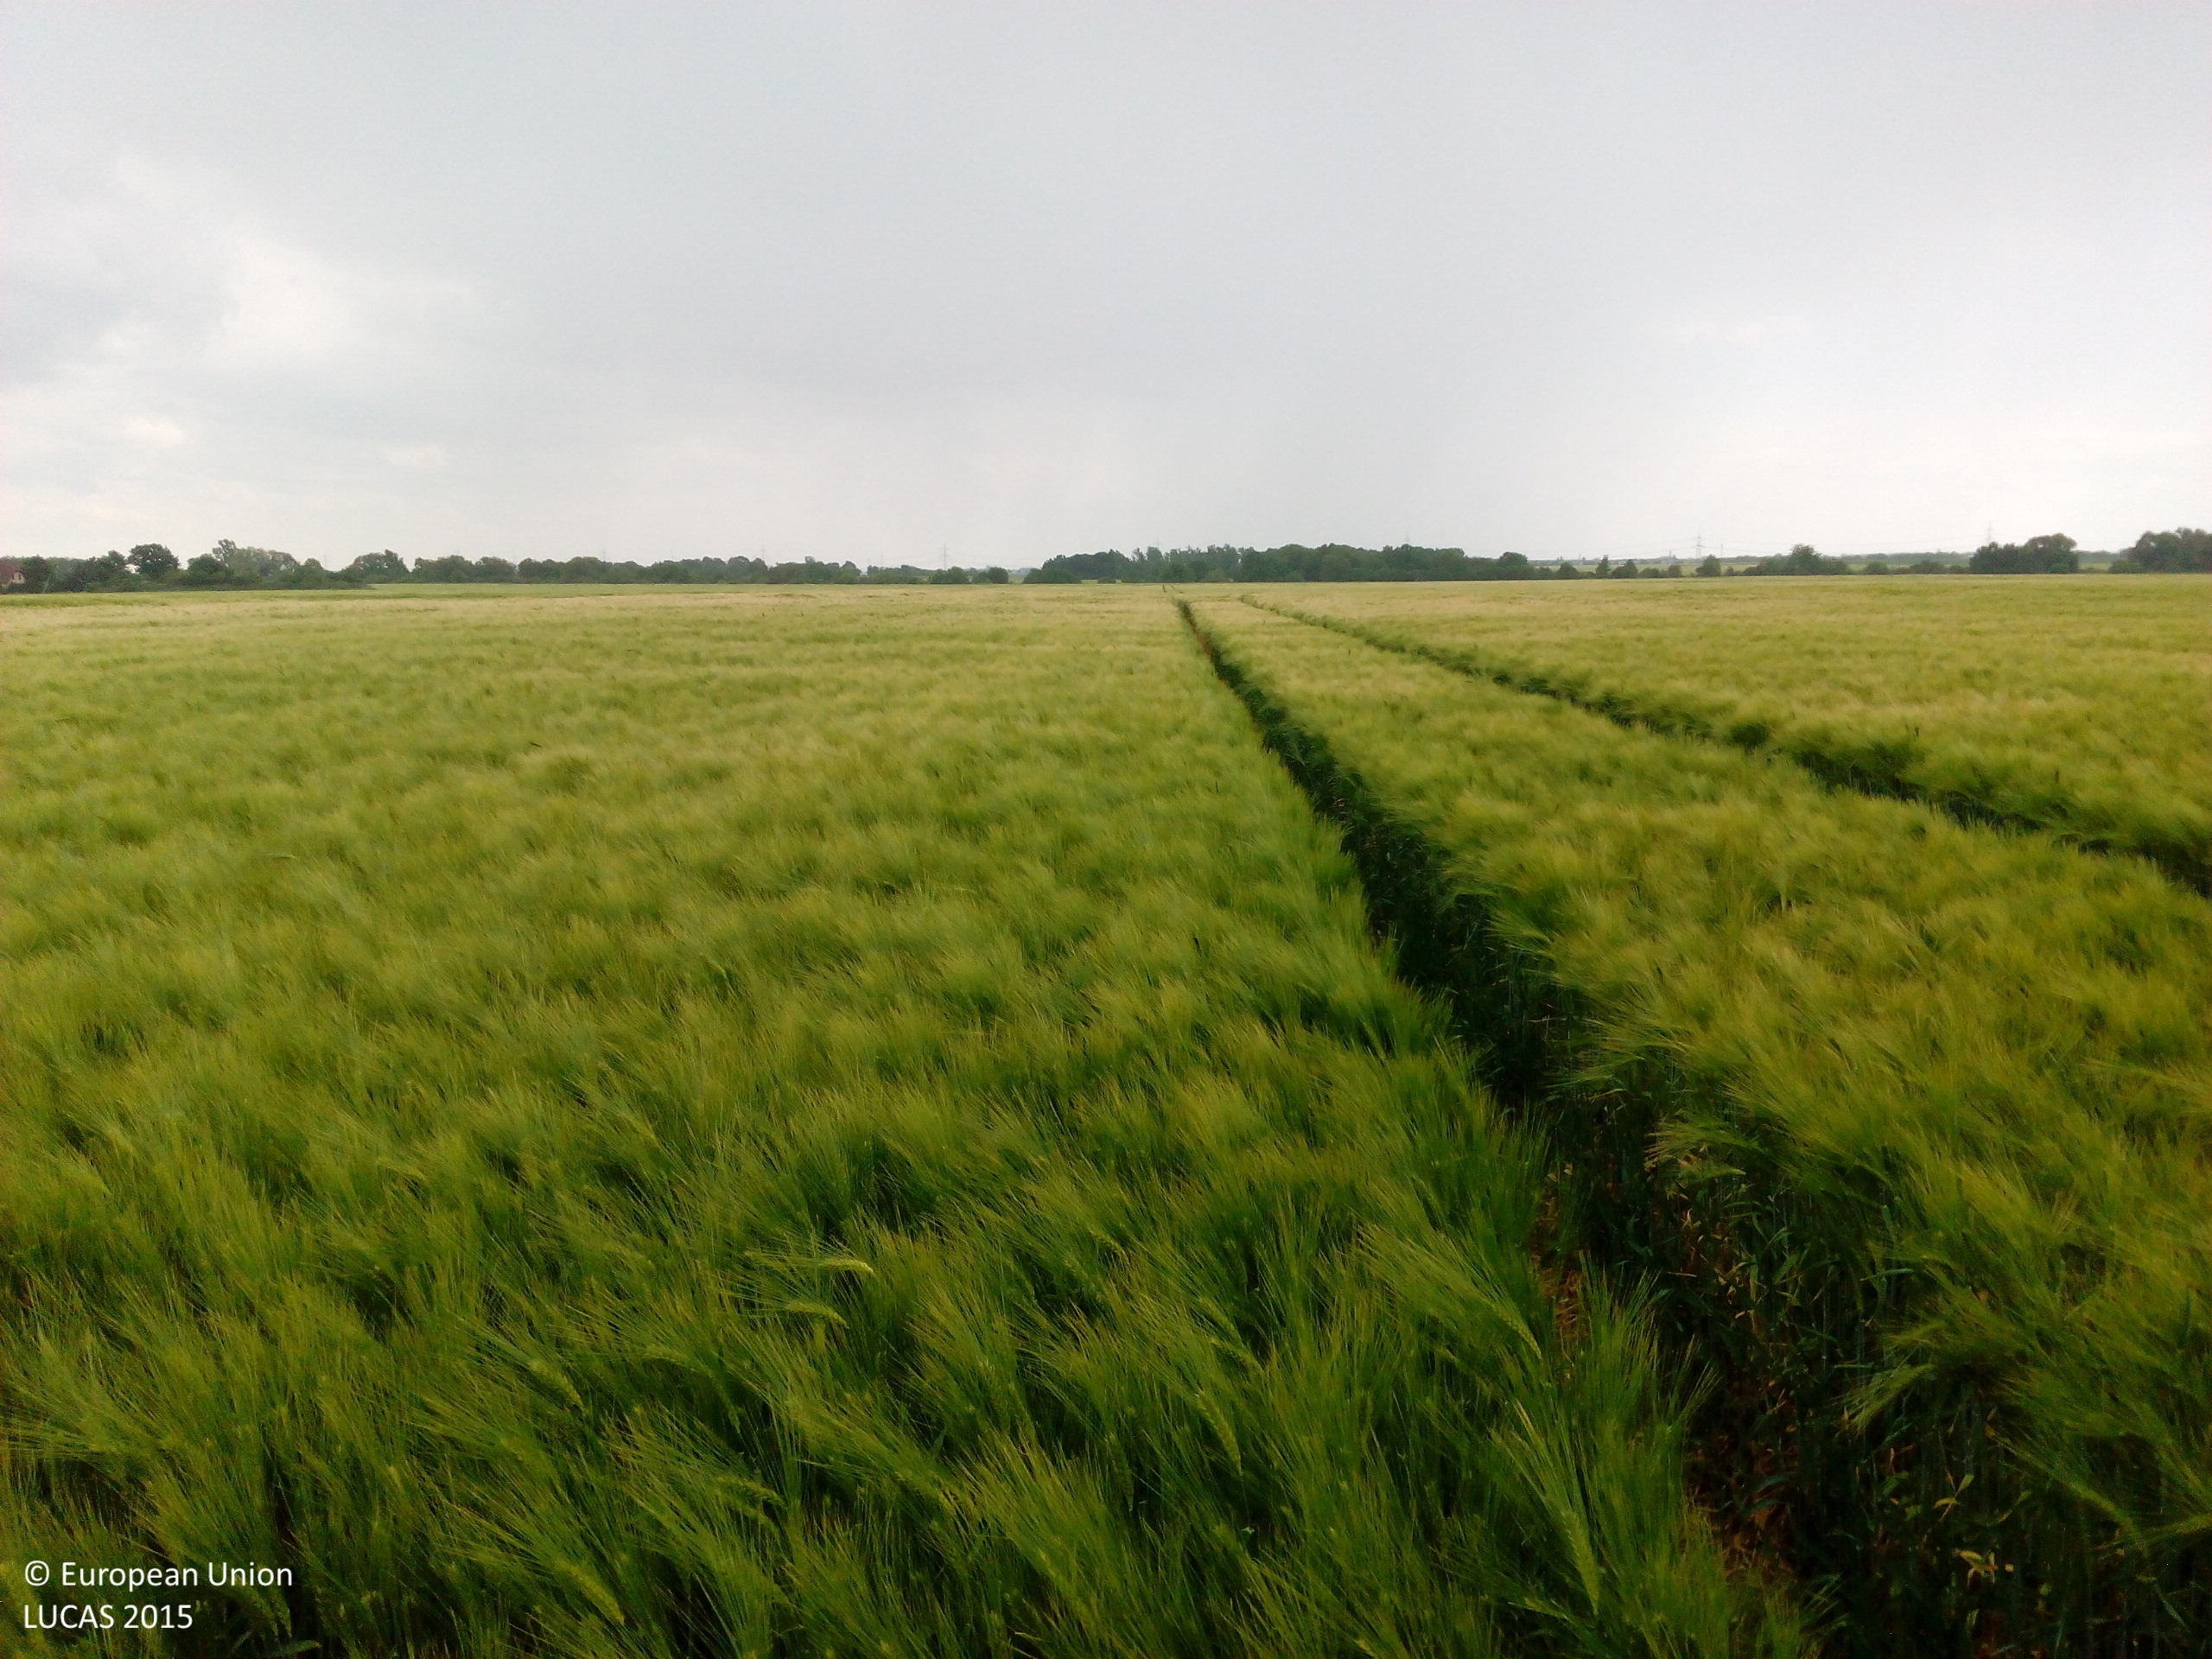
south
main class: Cropland
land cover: Barley
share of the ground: > 75 %
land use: Agriculture (excluding fallow land and kitchen gardens)
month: May
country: DE
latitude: 51.5624
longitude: 12.3799
